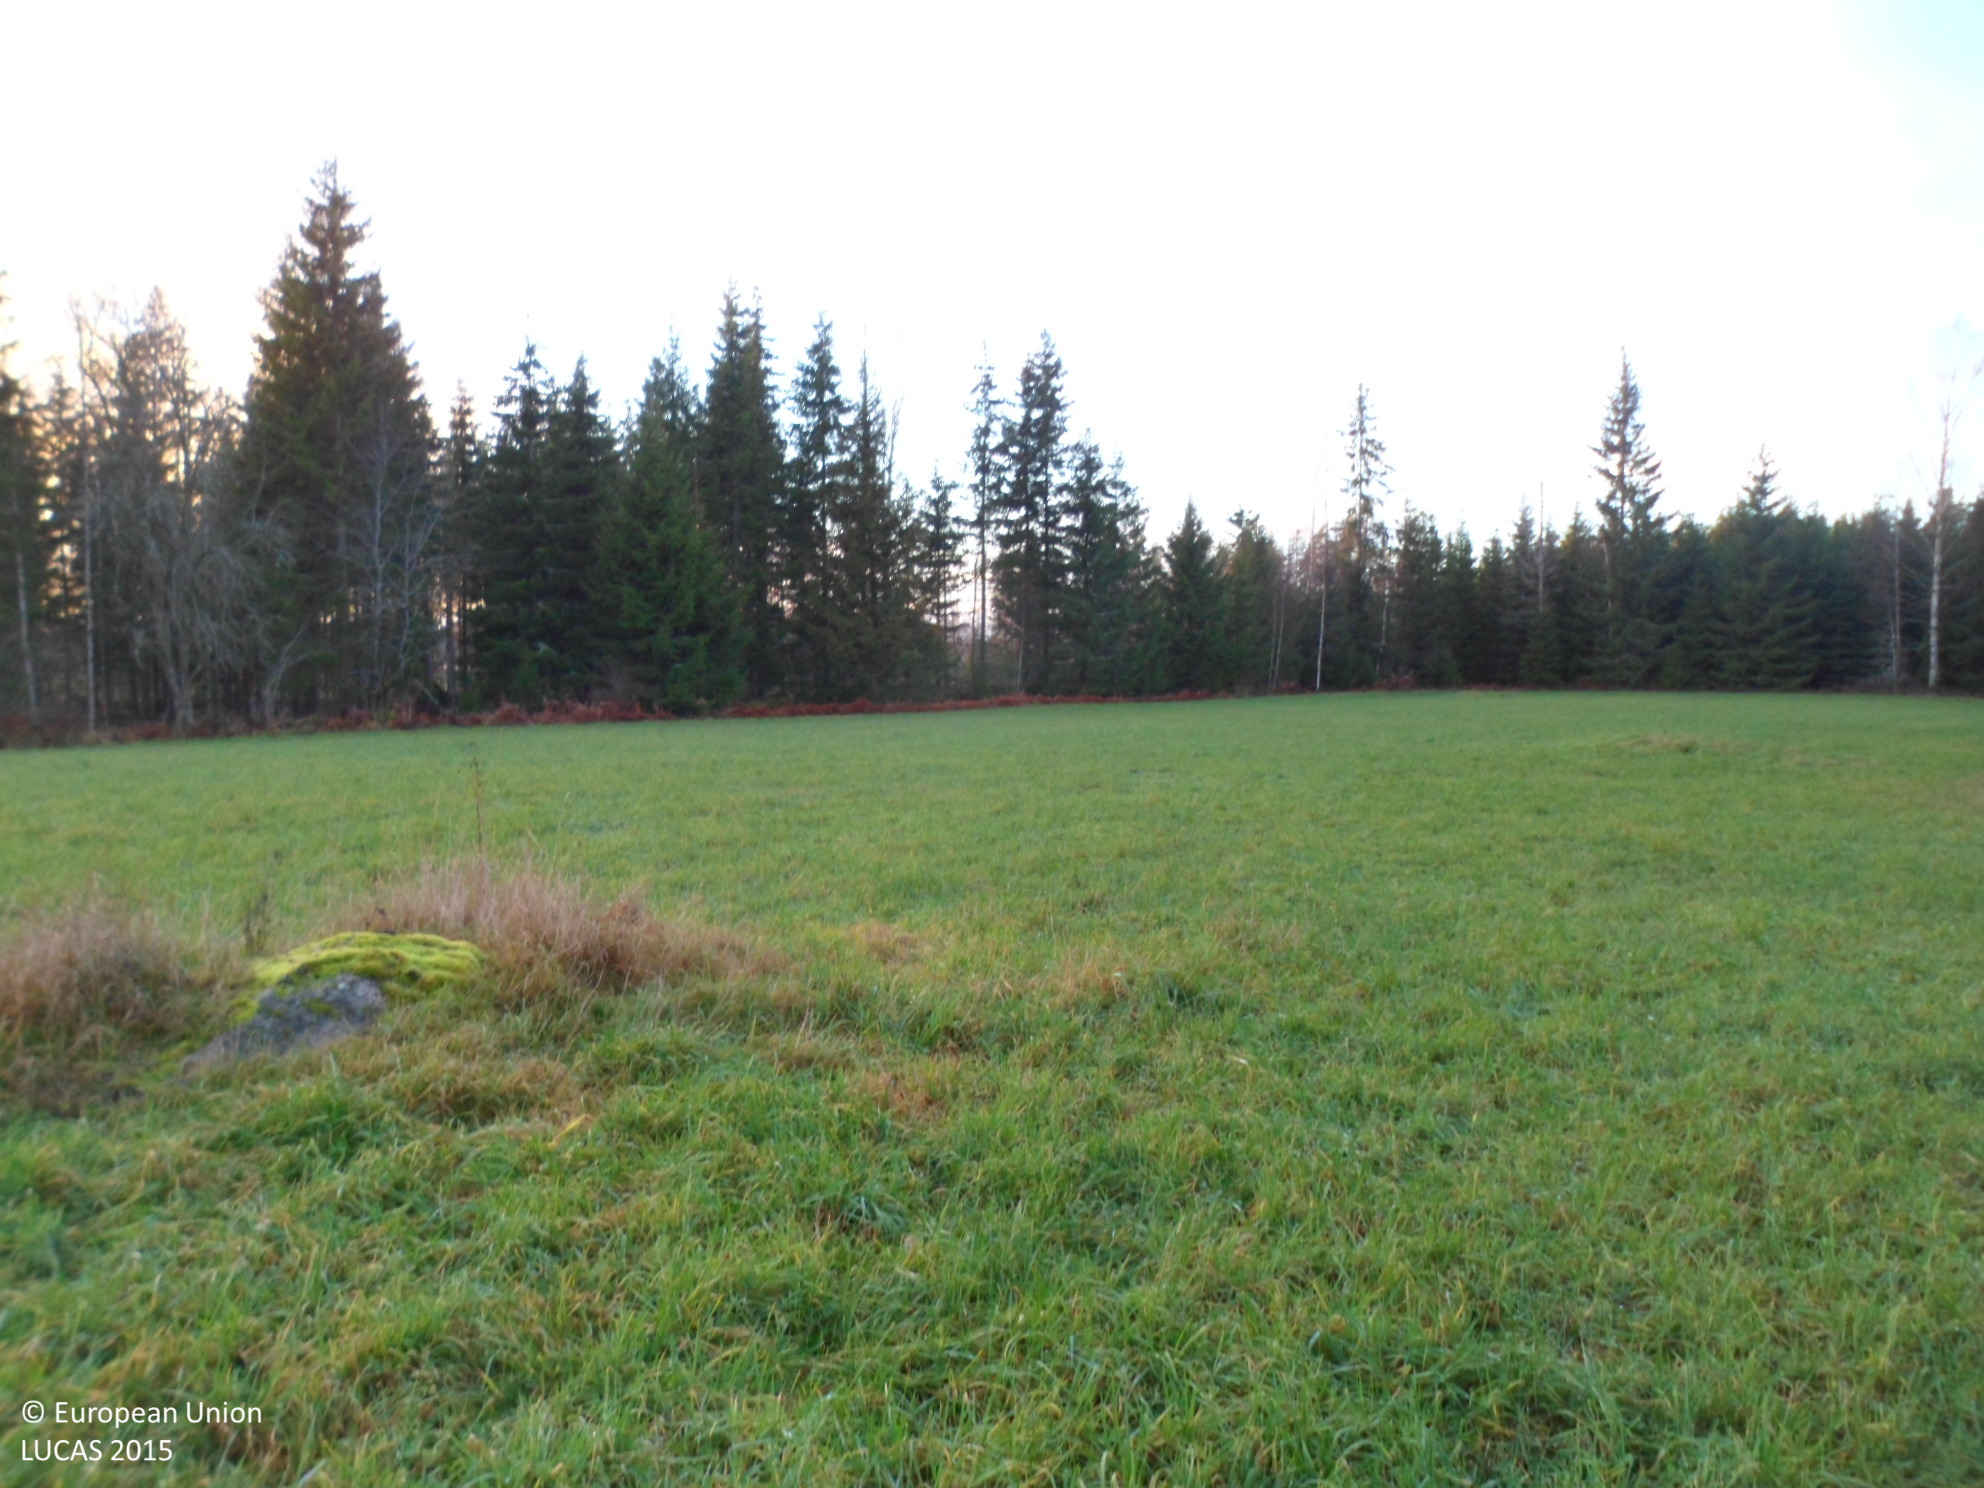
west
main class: Grassland
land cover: Grassland without tree/shrub cover
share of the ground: > 75 %
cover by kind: herbaceous plants 100 %
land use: Agriculture (excluding fallow land and kitchen gardens)
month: November
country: SE
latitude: 57.6334
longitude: 15.1712
